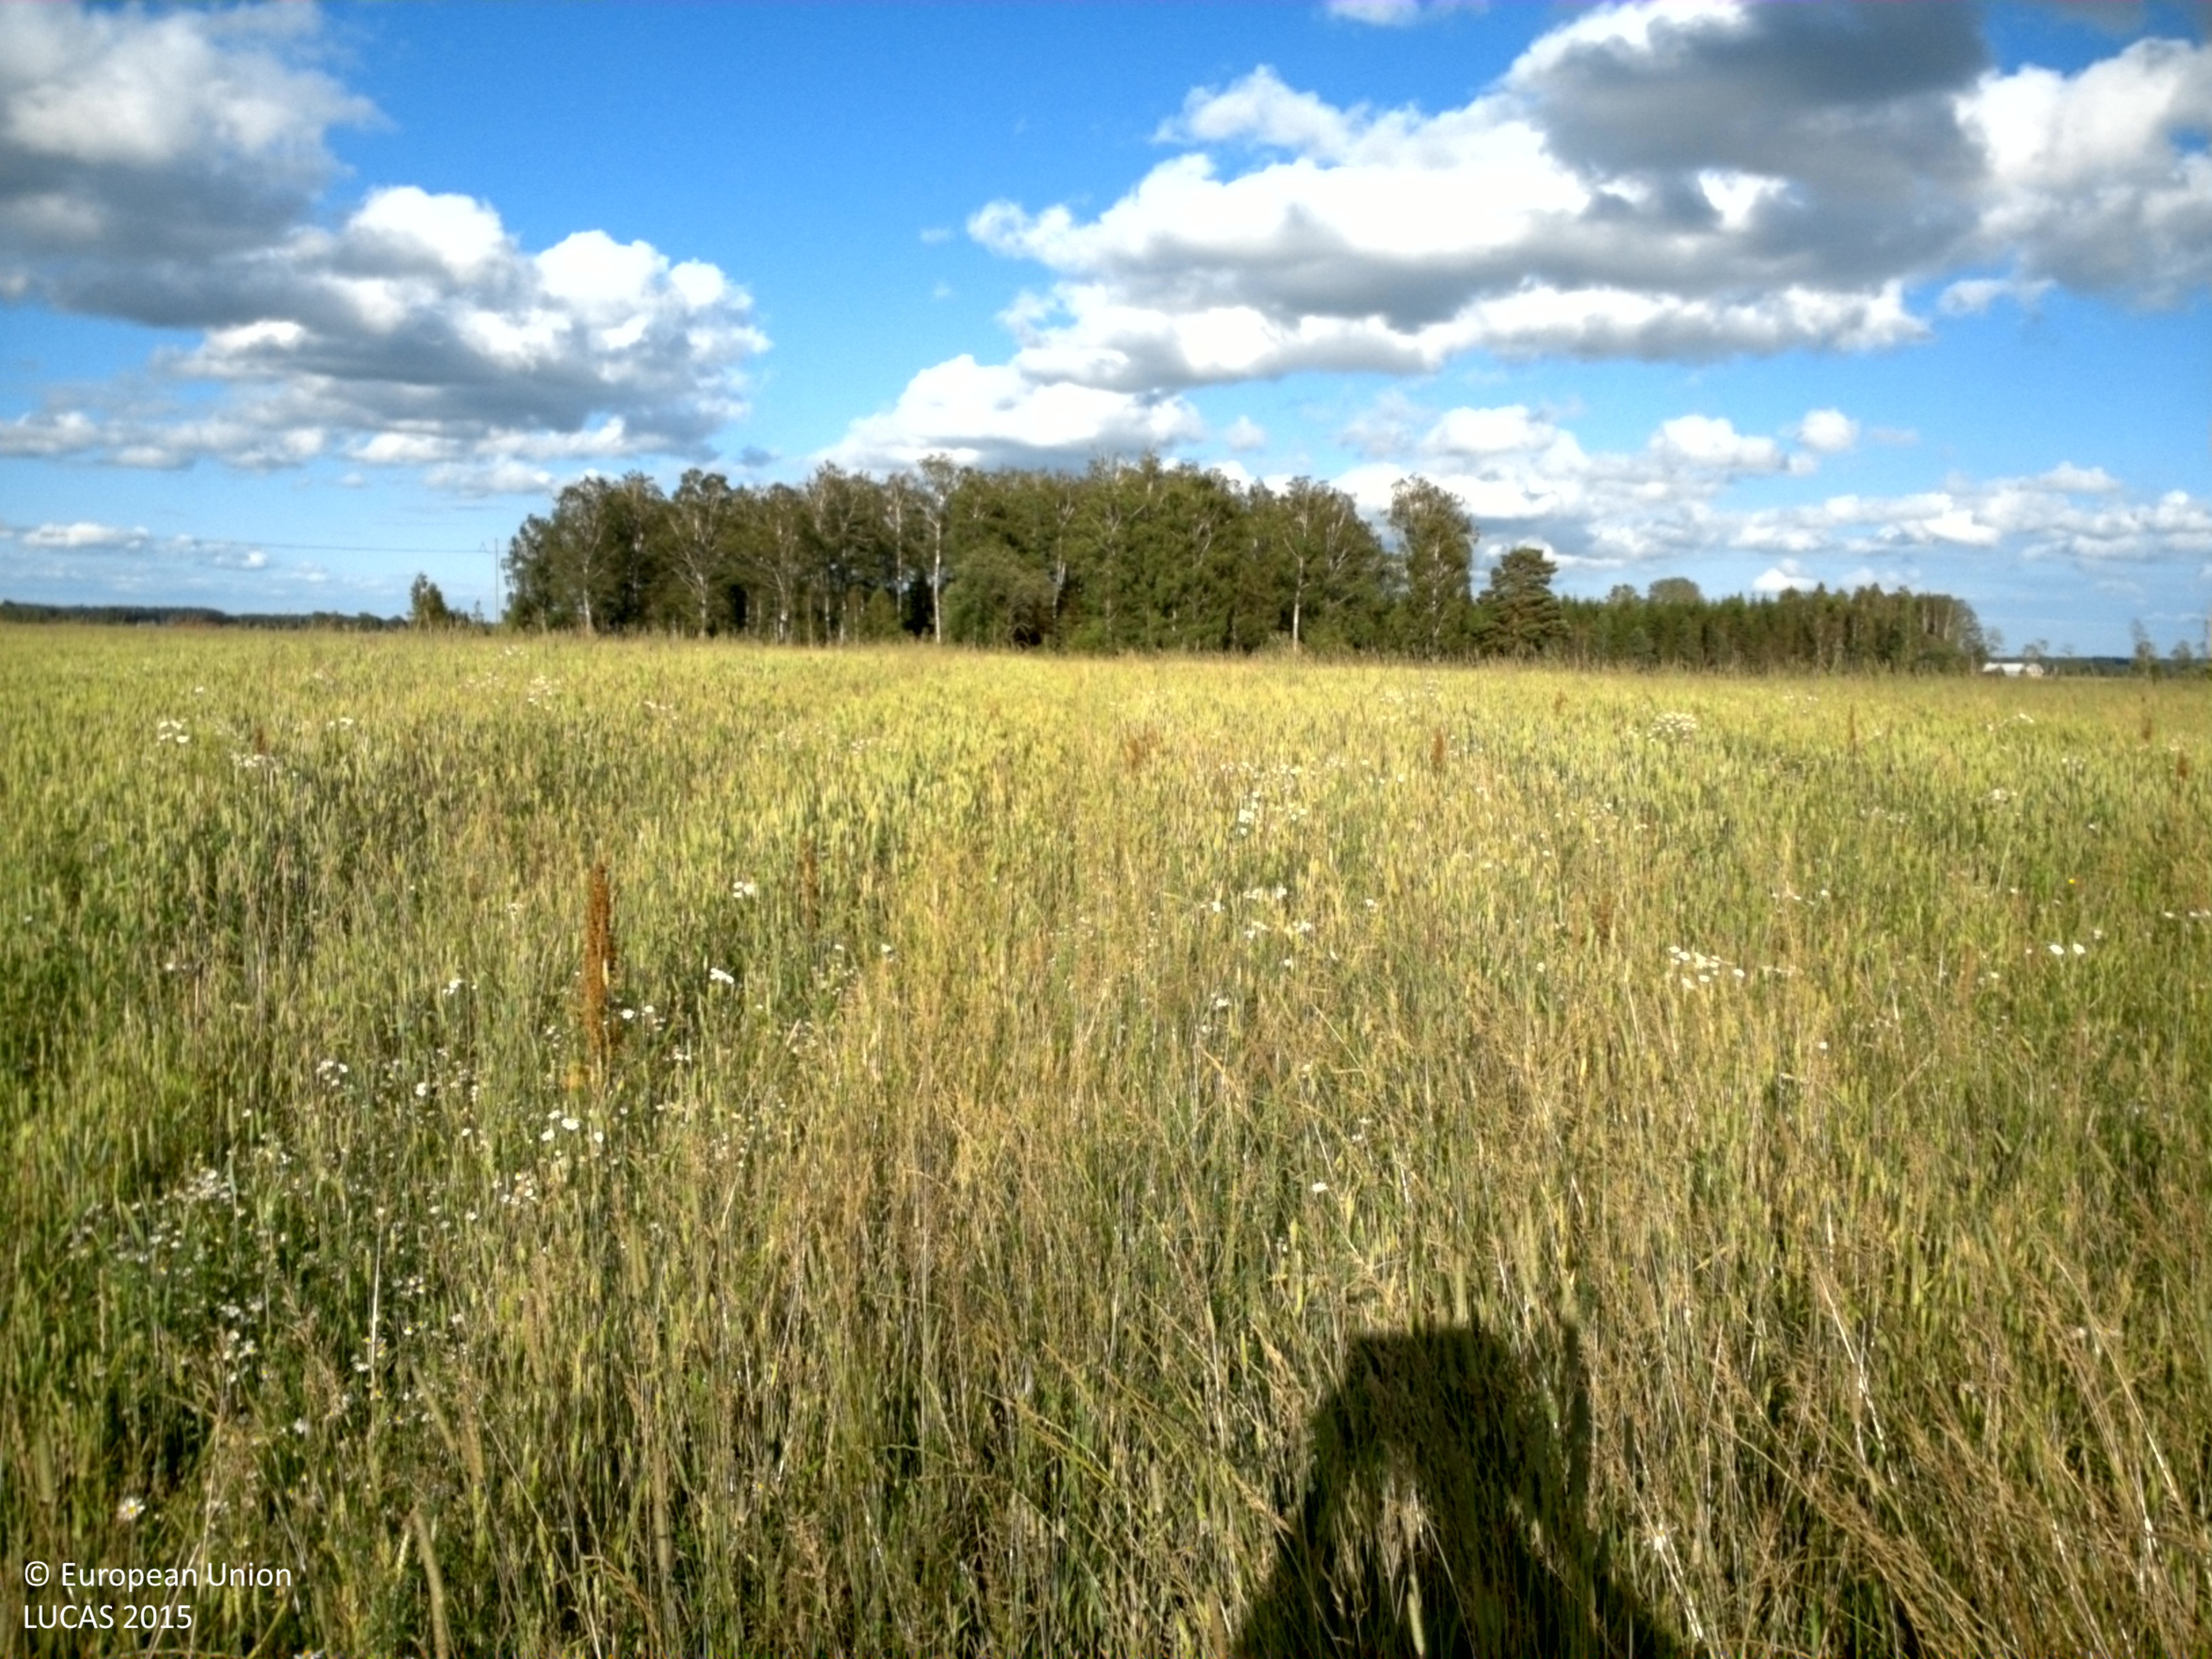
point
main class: Cropland
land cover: Common wheat
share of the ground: > 75 %
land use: Agriculture (excluding fallow land and kitchen gardens)
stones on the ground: > 50 %
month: July
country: SE
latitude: 58.3788
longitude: 13.9098
